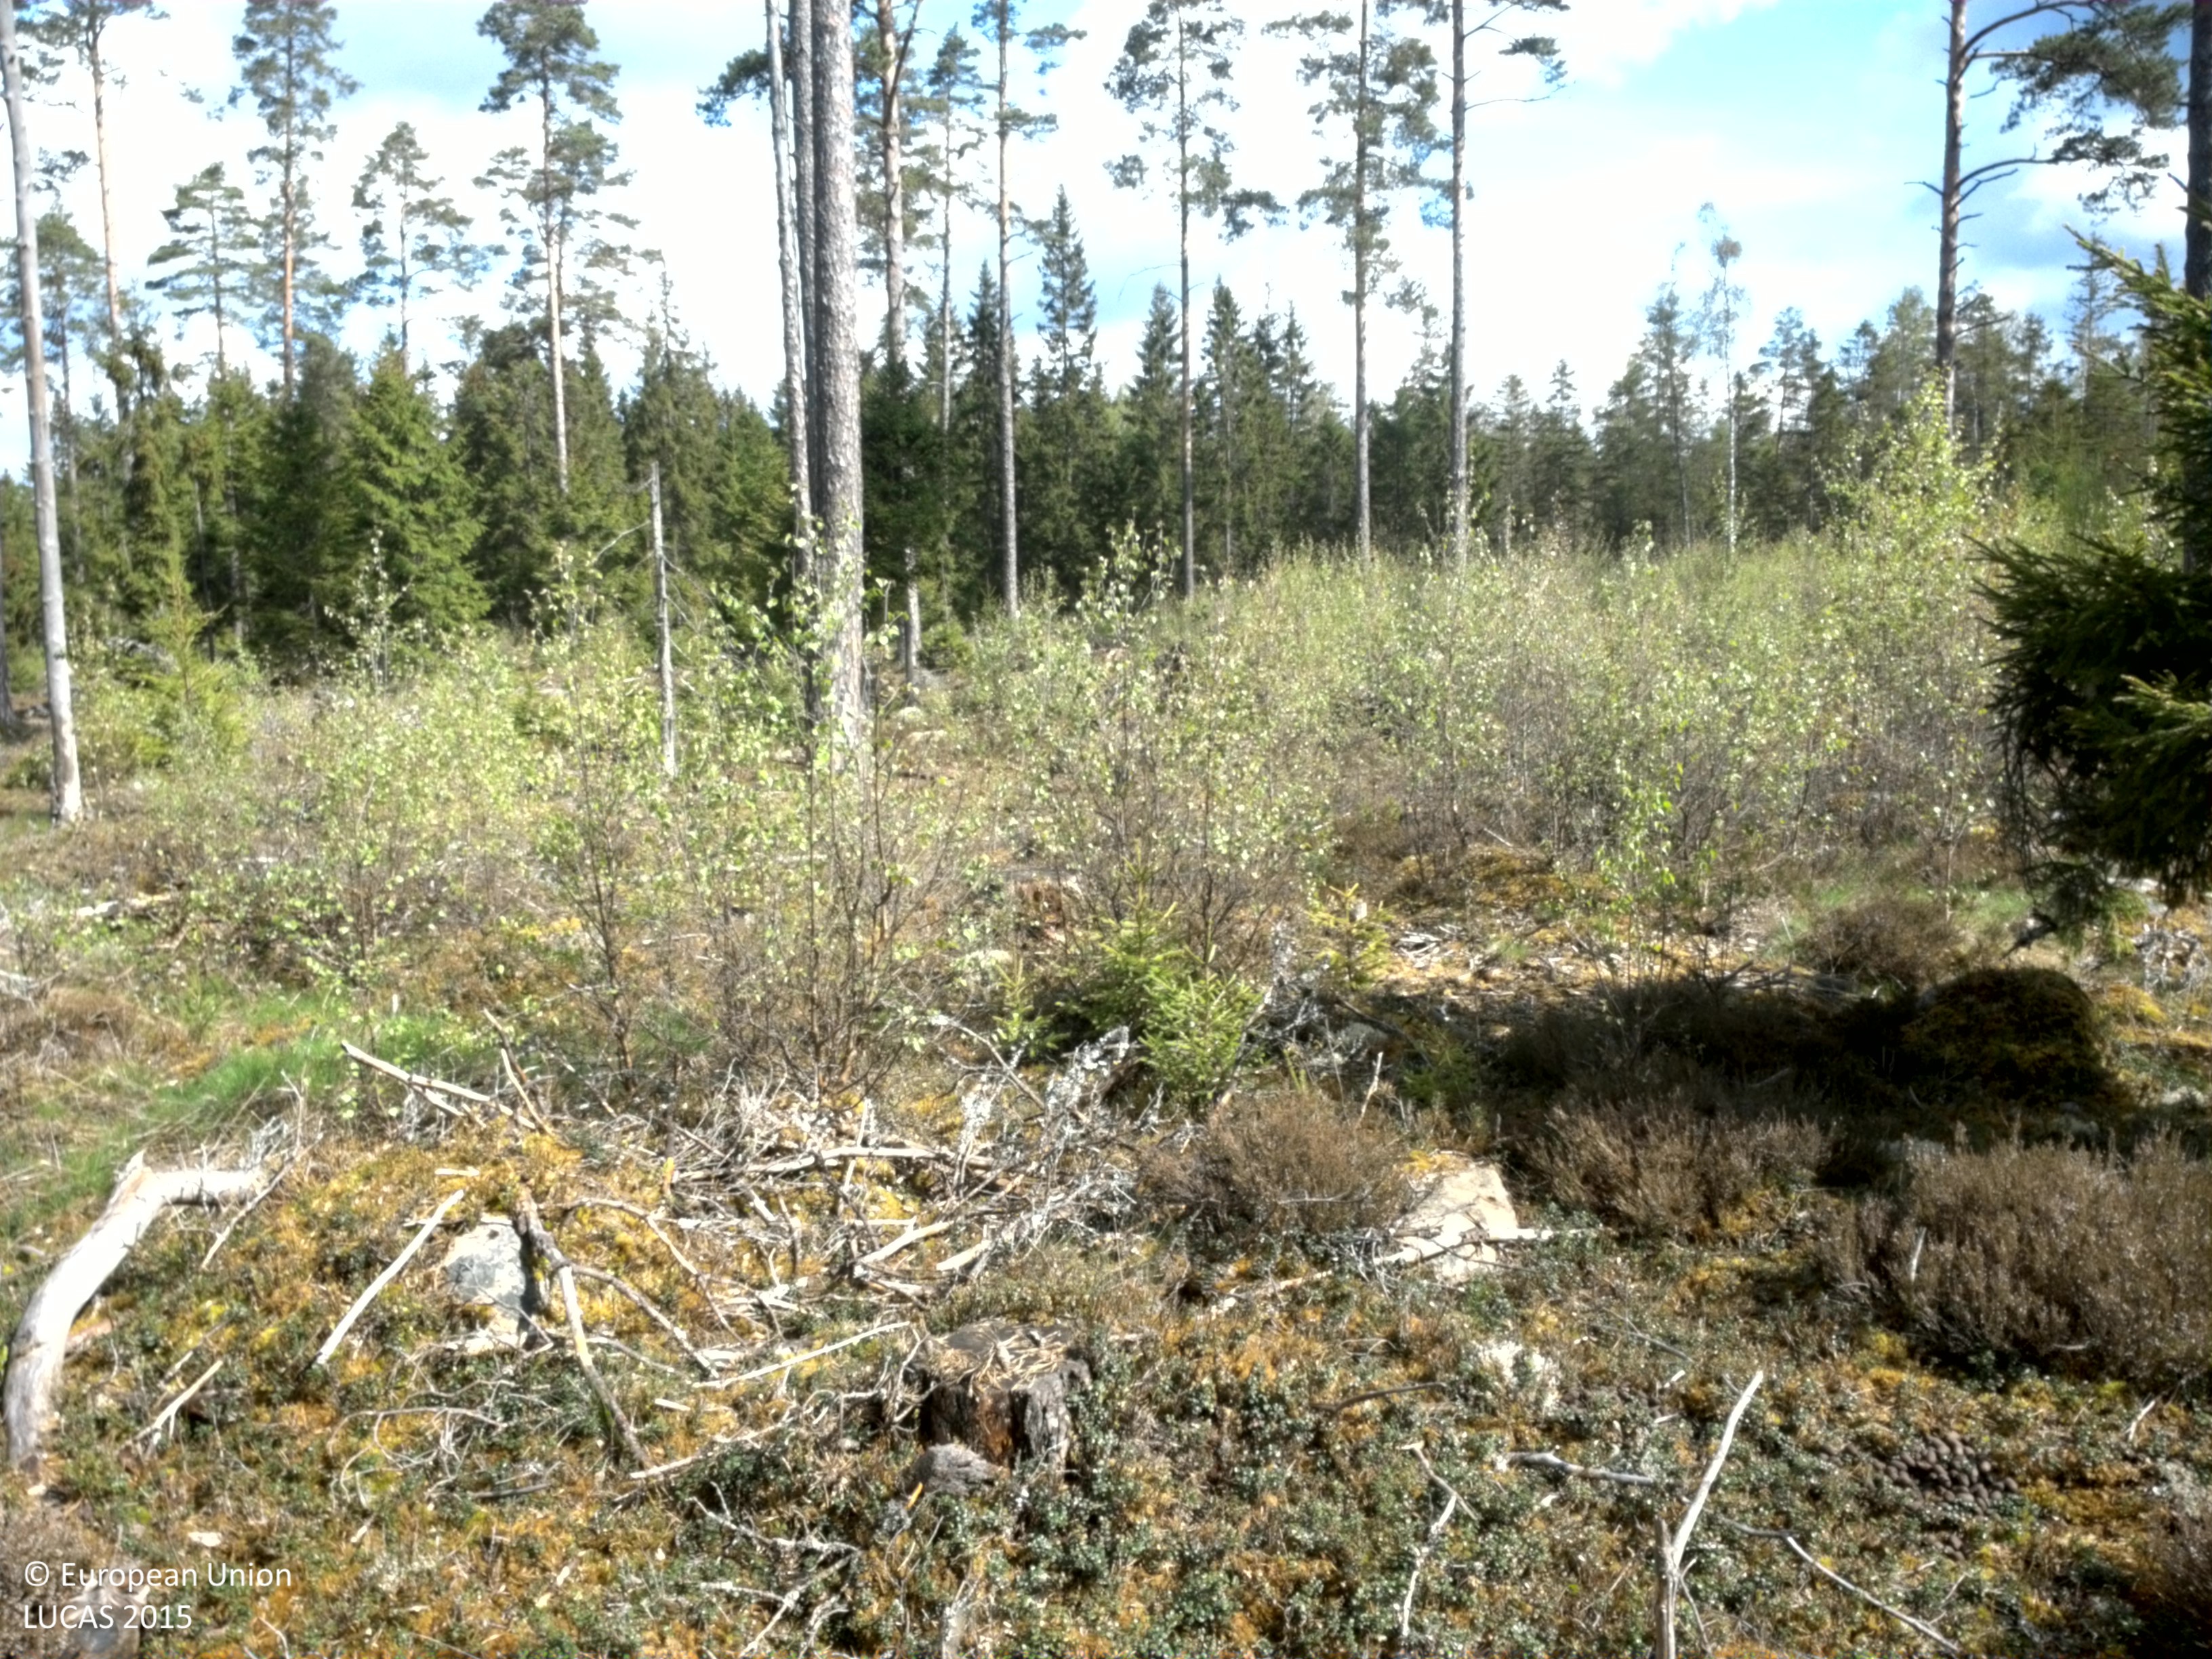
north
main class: Woodland
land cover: Pine dominated coniferous woodland
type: boreal forest
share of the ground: 25 - 50 %
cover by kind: coniferous forest trees 60 %, broadleaved forest trees 20 %, herbaceous plants 10 %, lichens and mosses 10 %
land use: Forestry
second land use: Amenities, museums, leisure
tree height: > 5 m
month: May
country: SE
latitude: 56.8984
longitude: 15.0706
